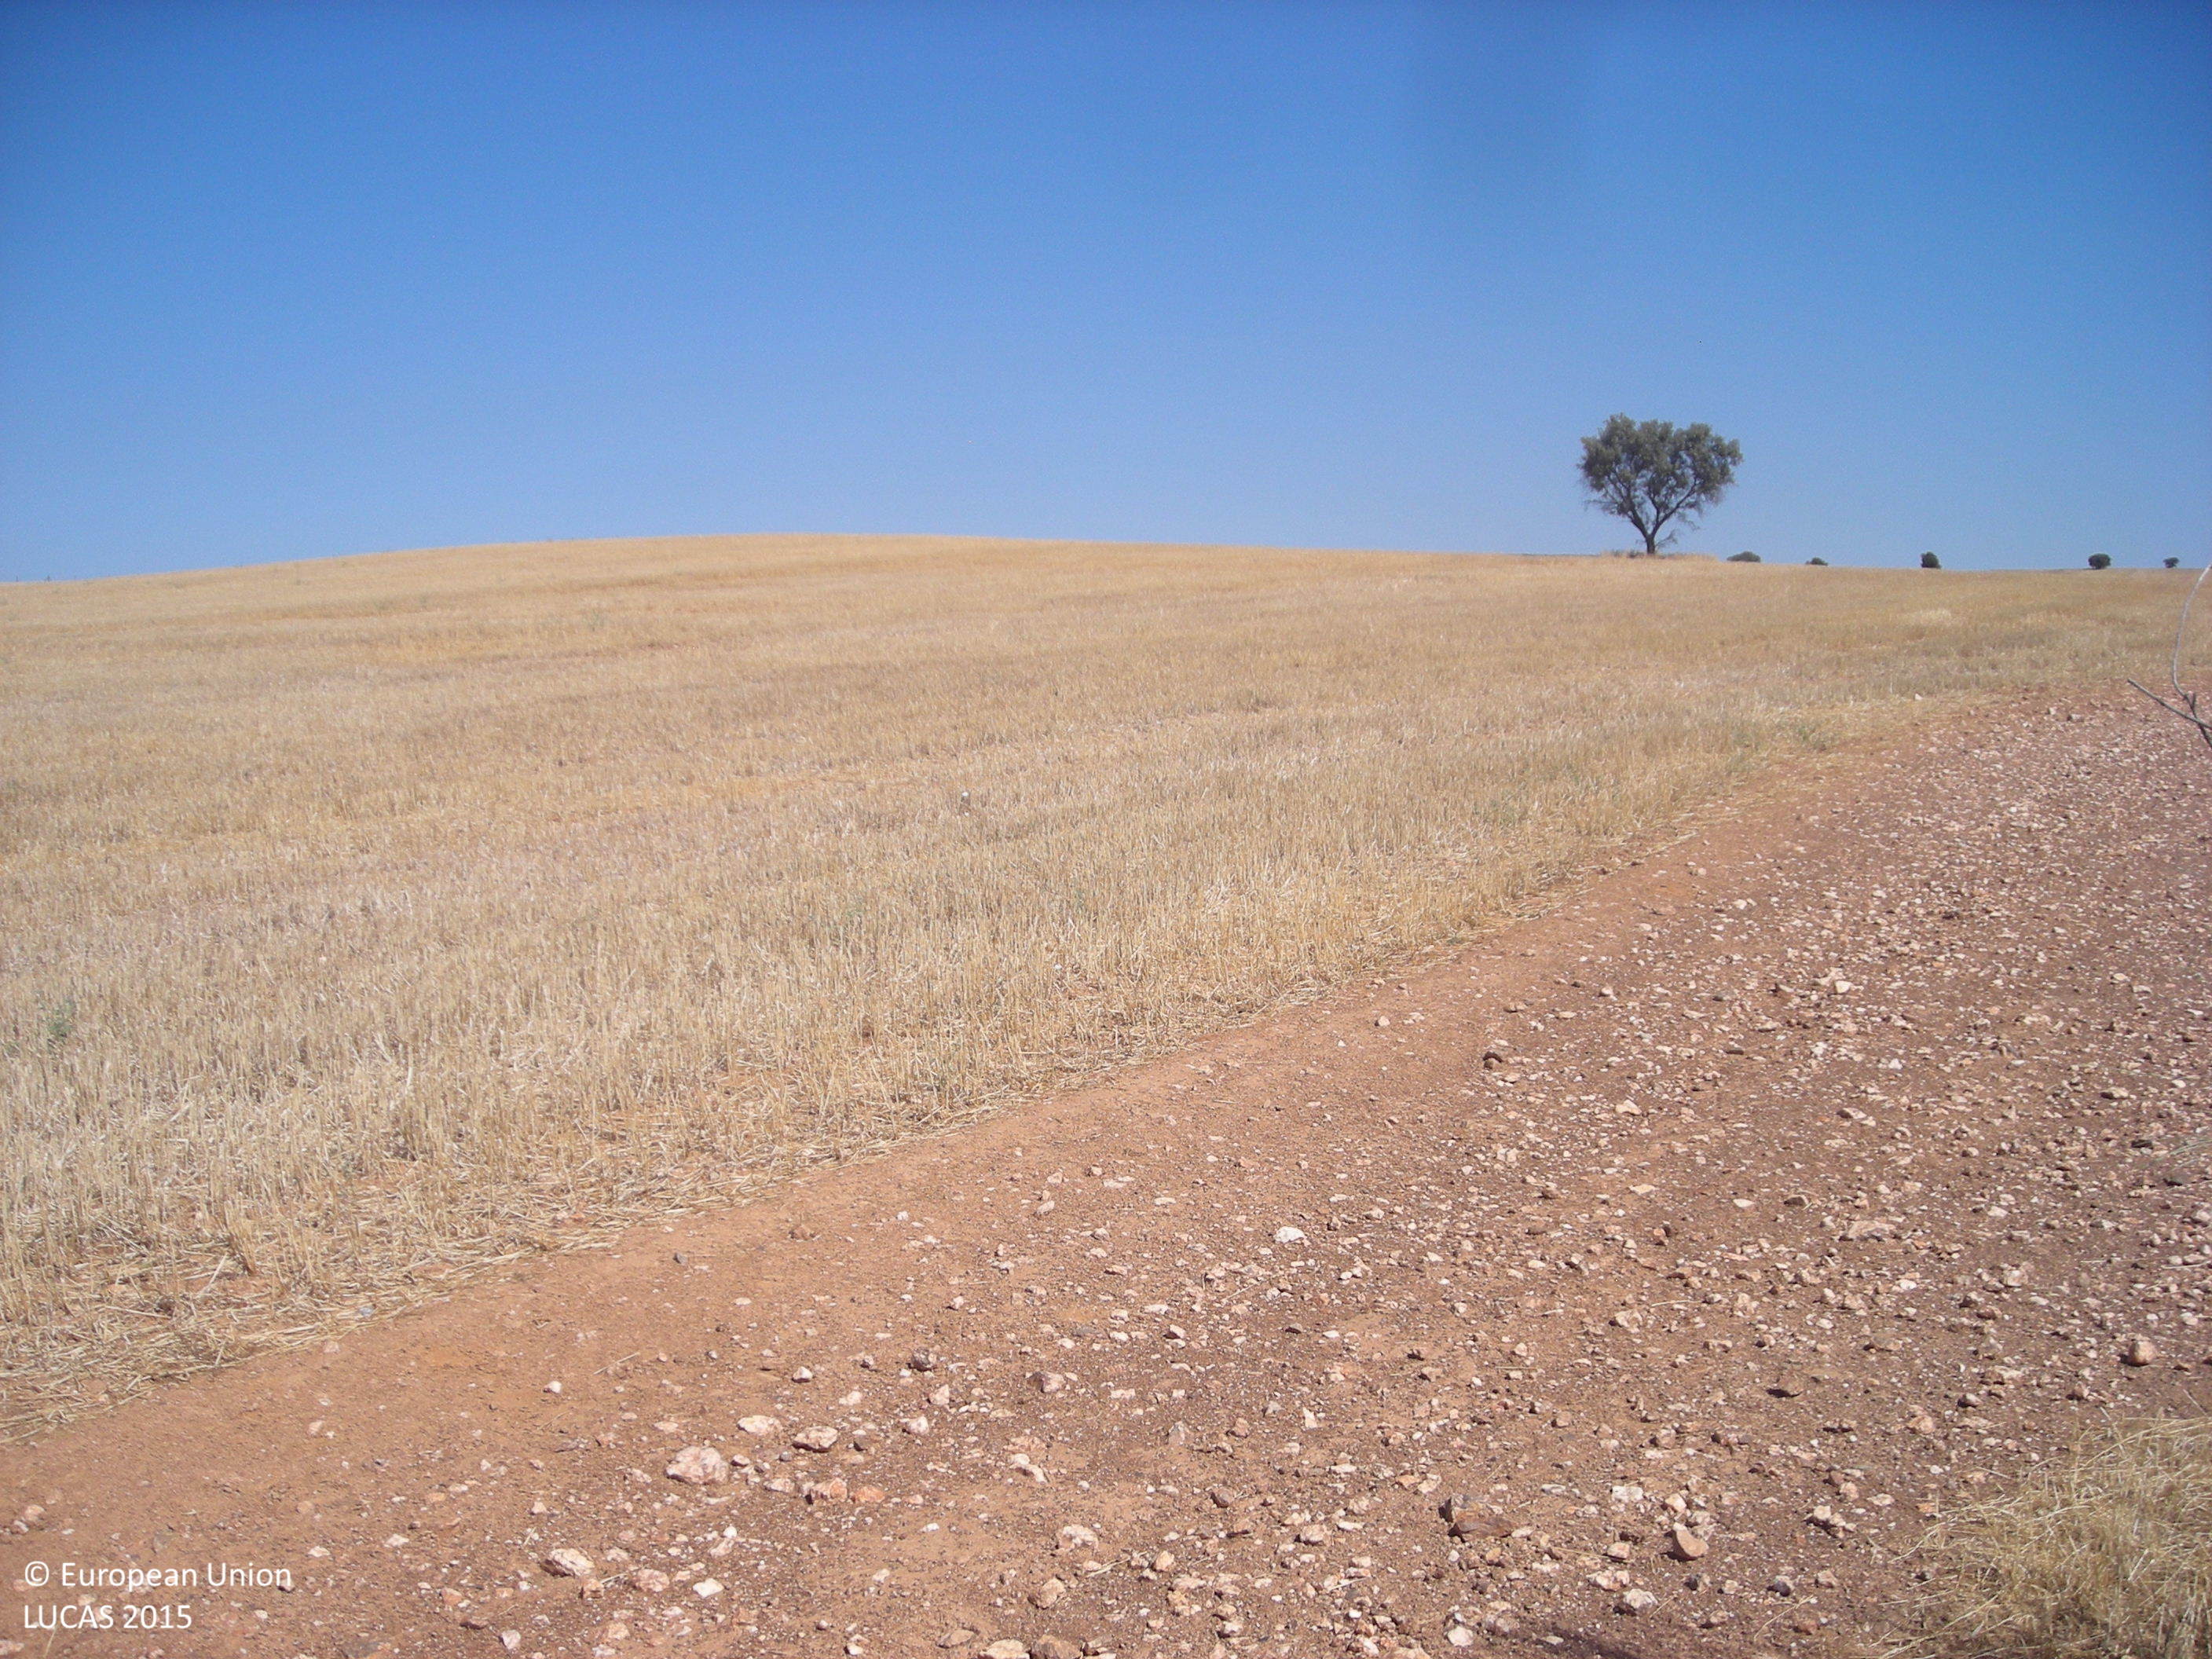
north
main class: Cropland
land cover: Mixed cereals for fodder
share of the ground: > 75 %
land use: Agriculture (excluding fallow land and kitchen gardens)
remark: Harvested field
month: July
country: ES
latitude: 38.8169
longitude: -5.8833
